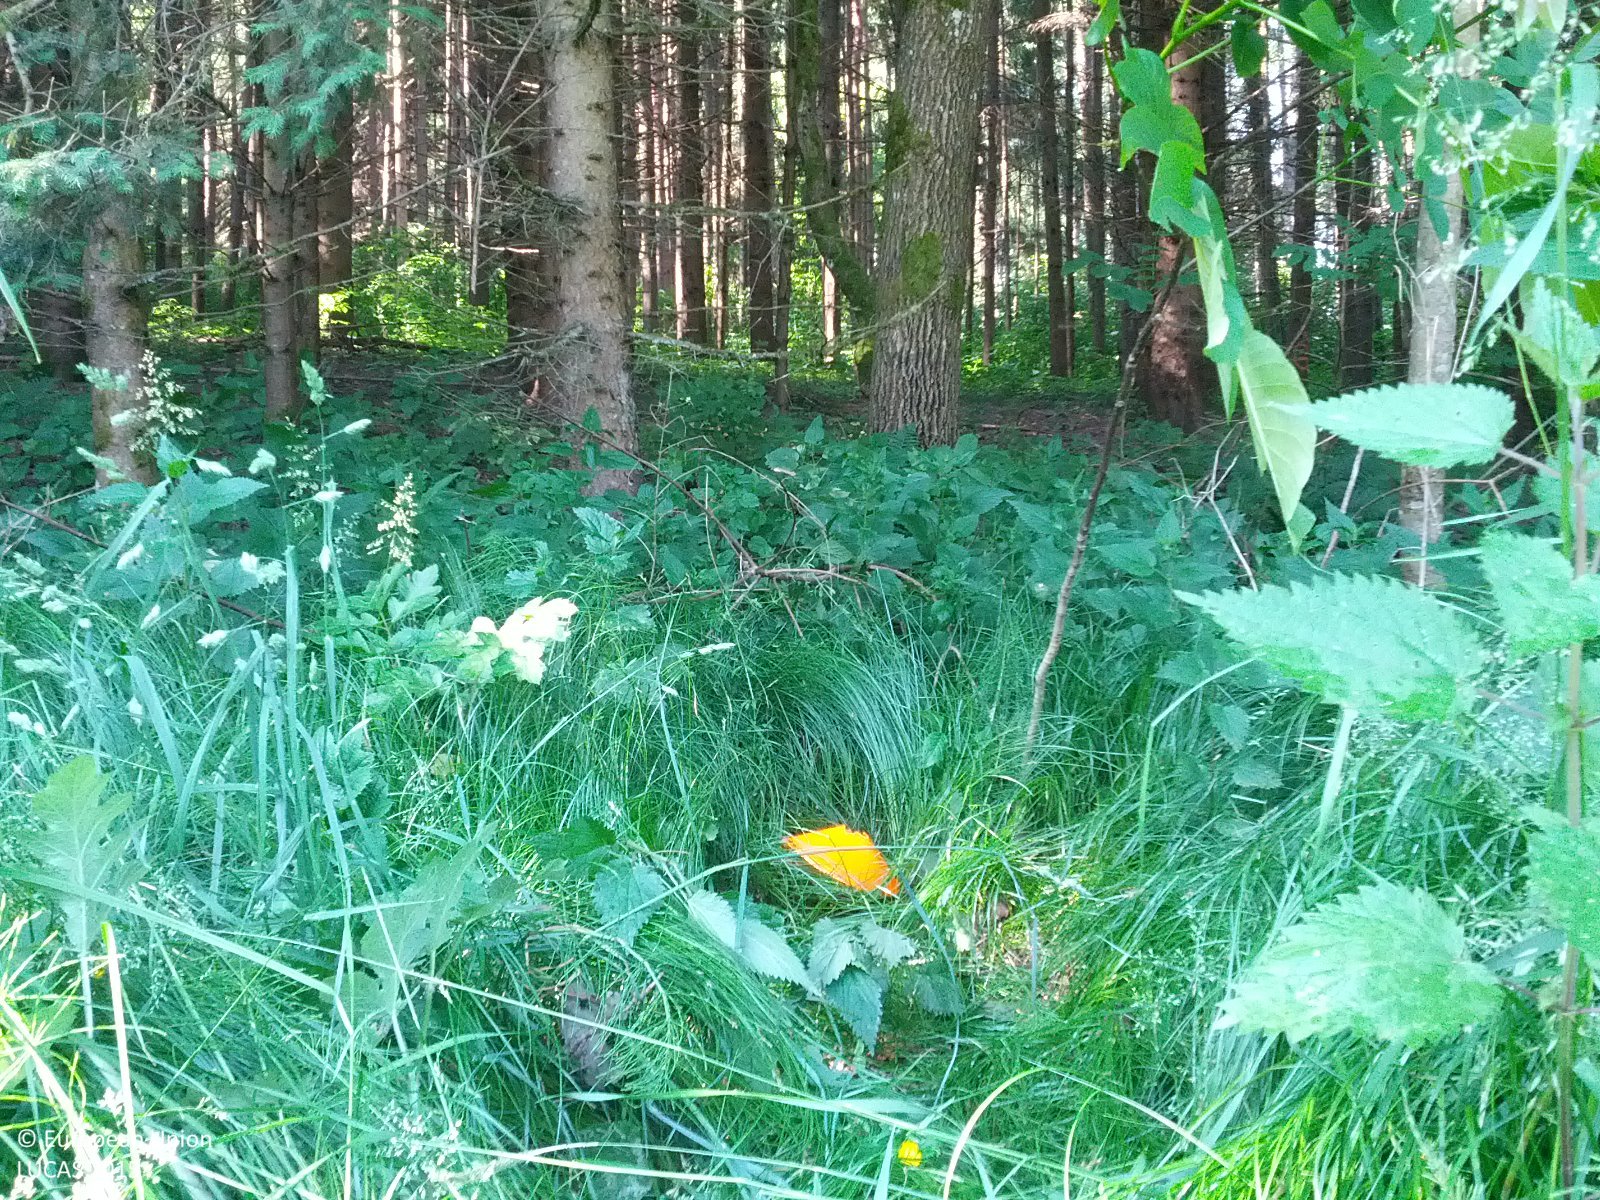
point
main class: Woodland
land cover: Spruce dominated coniferous woodland
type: hemiboreal forest and nemoral coniferous forest and mixed broadleaved-coniferous forest
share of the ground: > 75 %
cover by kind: coniferous forest trees 85 %, herbaceous plants 10 %, broadleaved forest trees 5 %
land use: Forestry
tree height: > 5 m
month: June
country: AT
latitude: 47.2025
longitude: 16.1669
